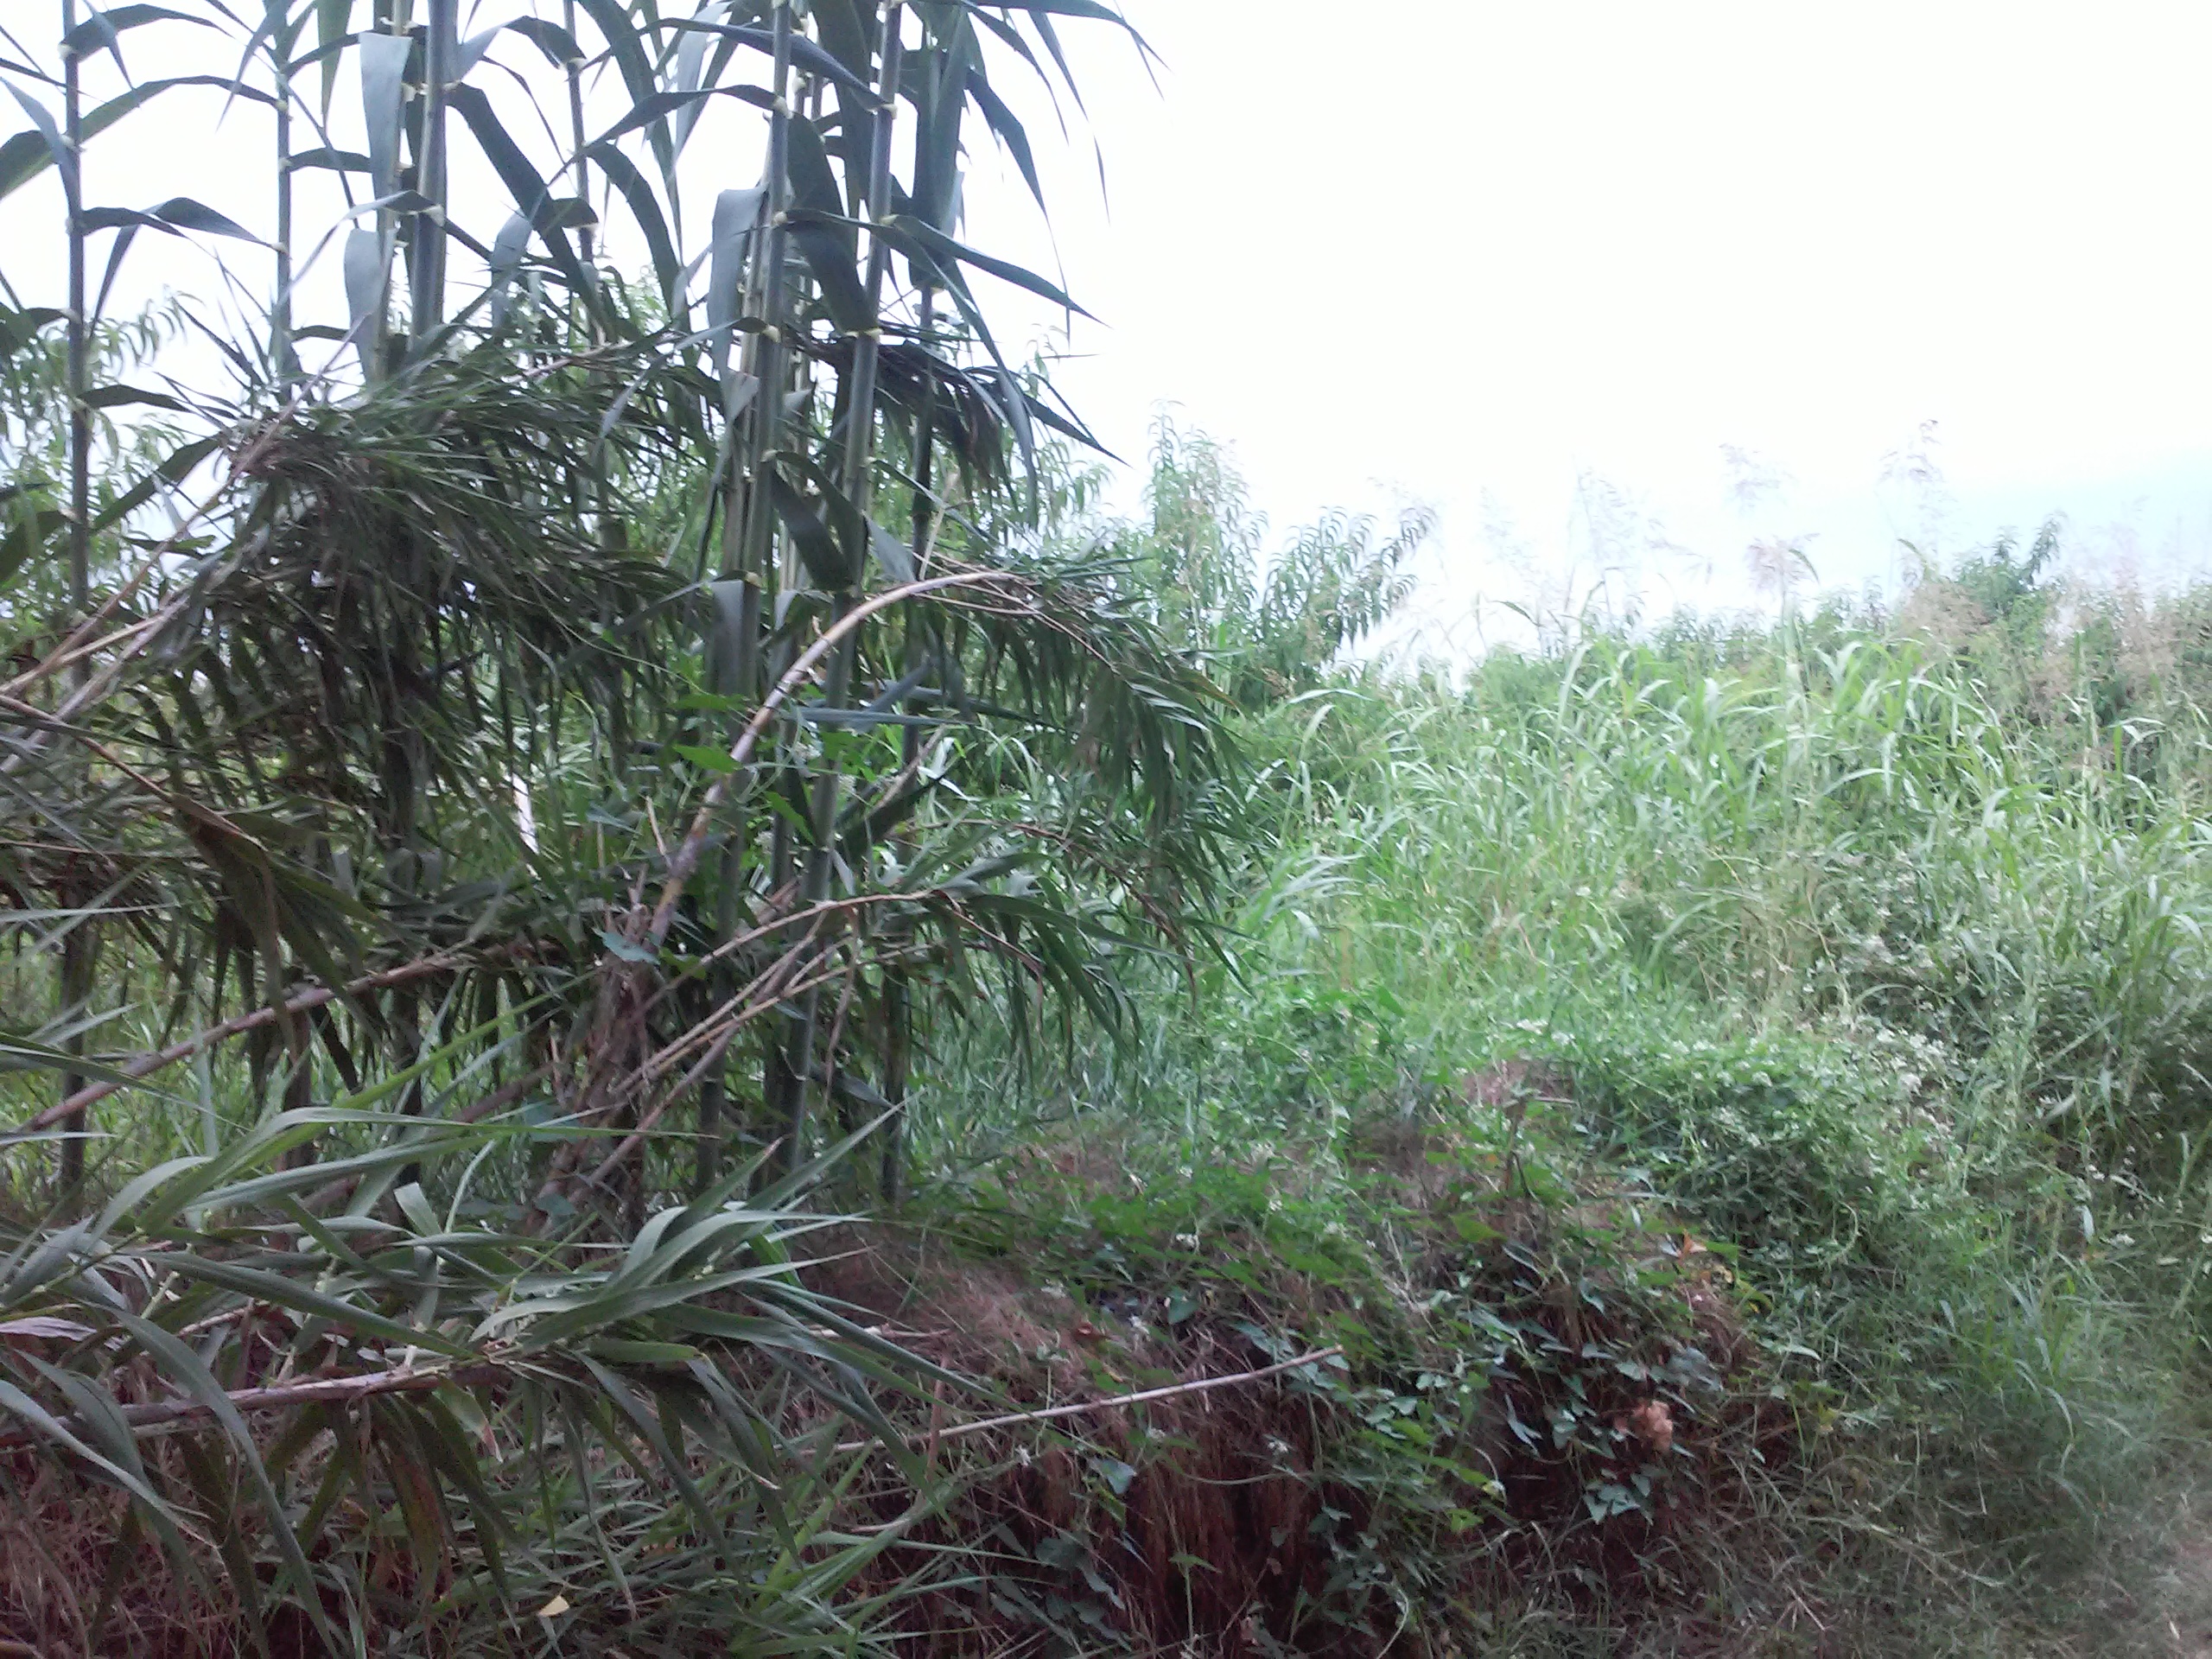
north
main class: Woodland
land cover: Broadleaved woodland
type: floodplain forest
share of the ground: 10 - 25 %
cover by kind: broadleaved forest trees 50 %, shrubs 25 %, herbaceous plants 25 %
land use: Semi-natural and natural areas not in use
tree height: < 5 m
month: July
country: ES
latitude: 41.5346
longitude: 0.5070
